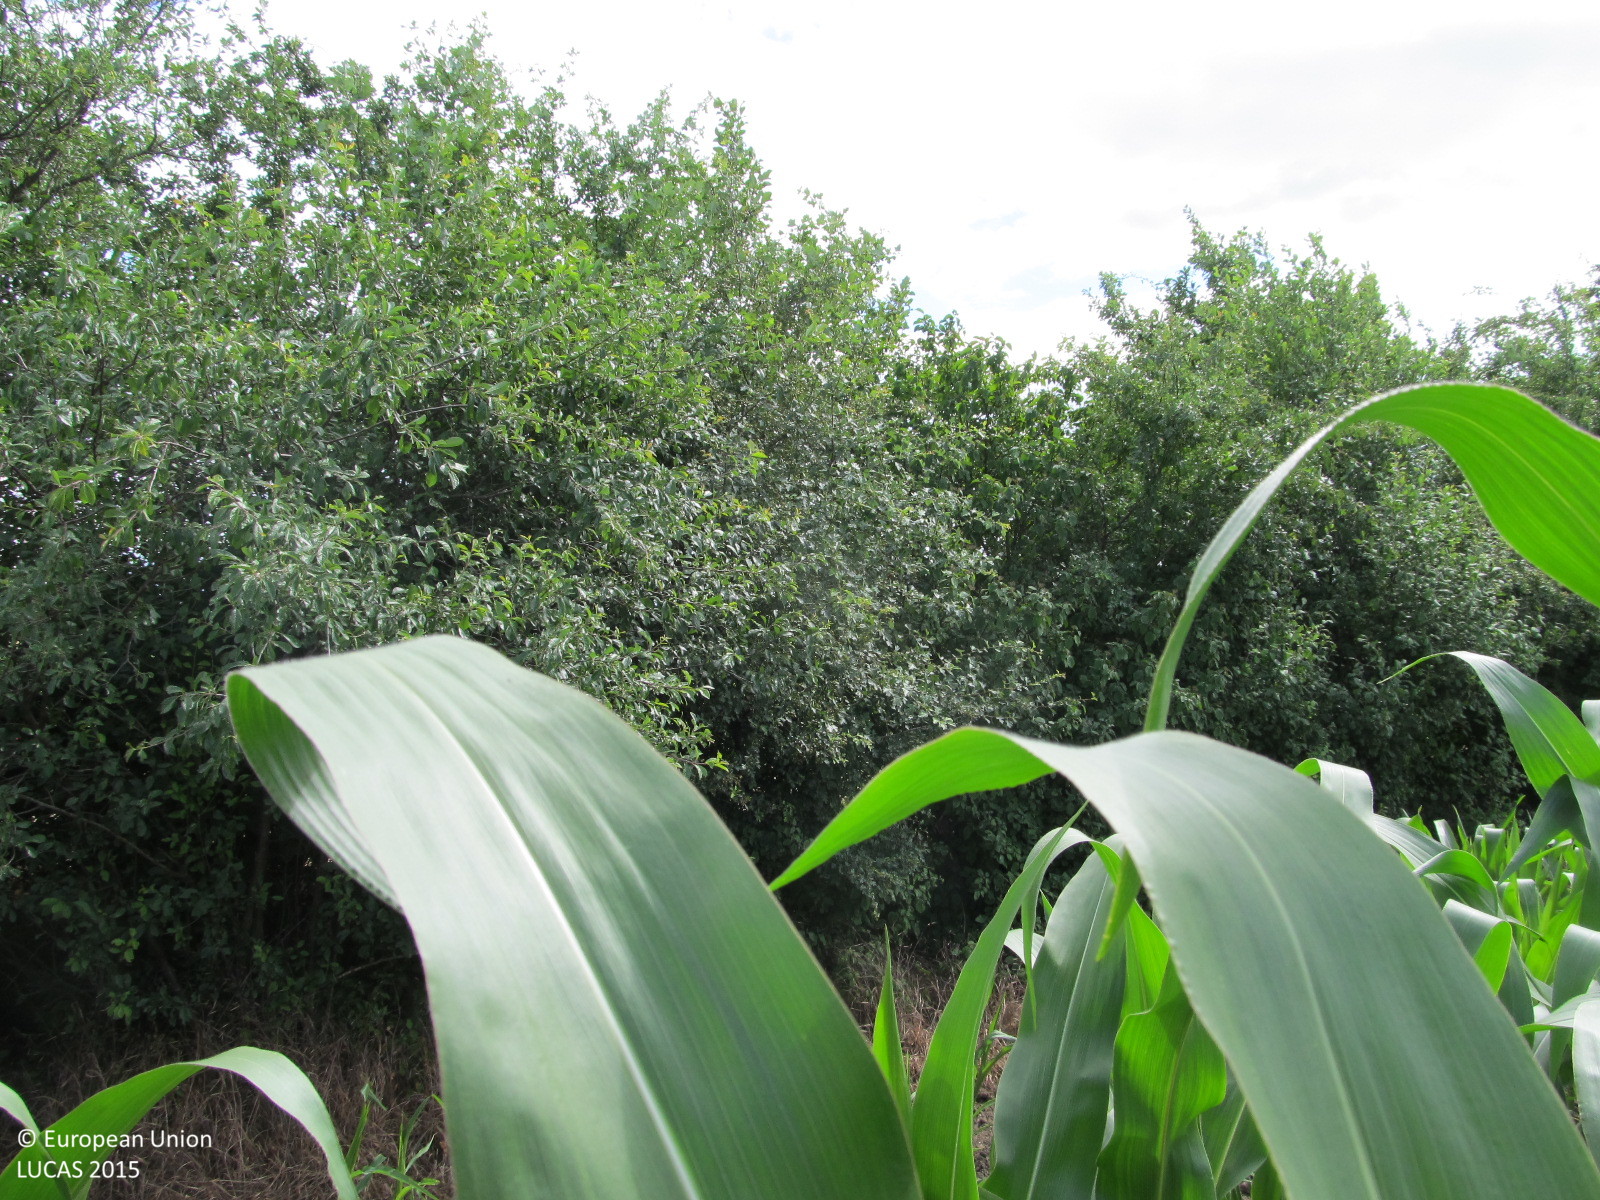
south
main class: Cropland
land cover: Maize
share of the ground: 25 - 50 %
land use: Agriculture (excluding fallow land and kitchen gardens)
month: June
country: AT
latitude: 48.7173
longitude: 16.1895
